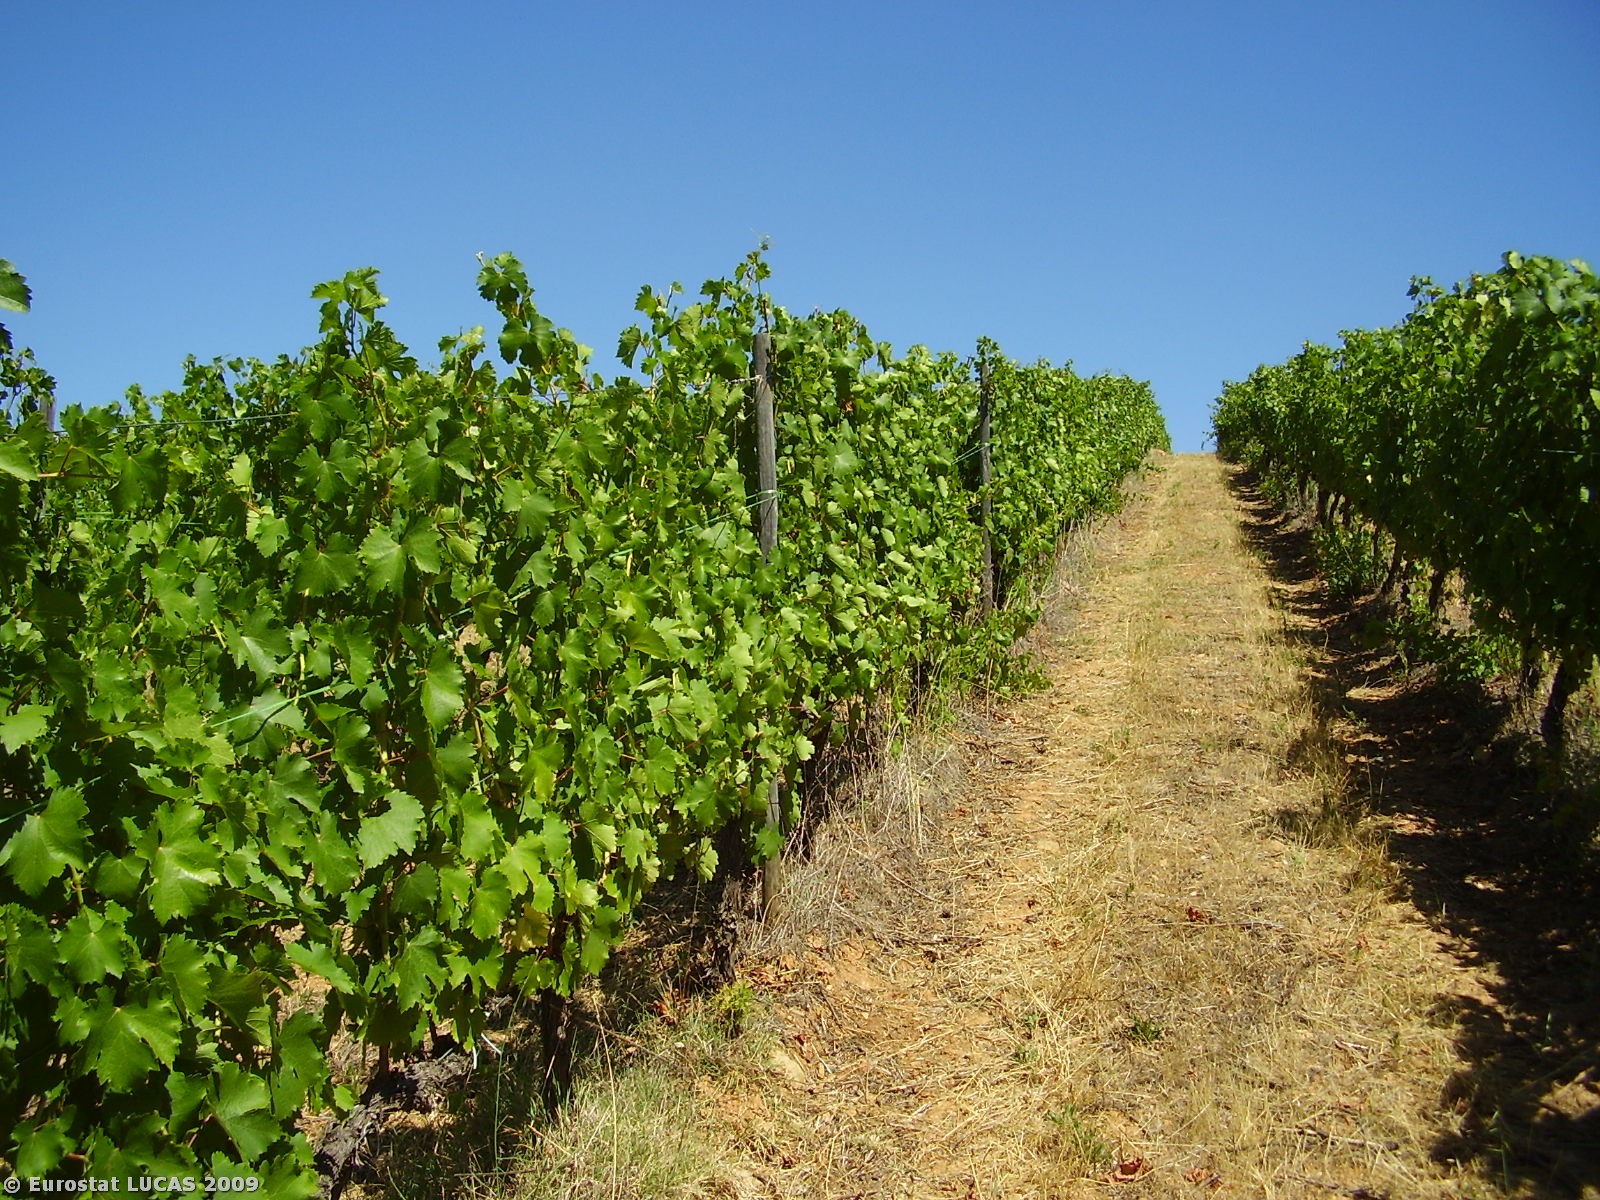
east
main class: Cropland
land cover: Vineyards
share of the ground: < 10 %
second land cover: Spontaneously vegetated surfaces
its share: > 75 %
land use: Agriculture (excluding fallow land and kitchen gardens)
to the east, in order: Vineyards; Spontaneously vegetated surfaces; Vineyards; Tracks; Vineyards; Tracks; Vineyards; Tracks; Shruby margins; Other structural elements; Paved roads, cycling and walking lanes
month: July
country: PT
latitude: 41.6010
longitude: -7.3666
